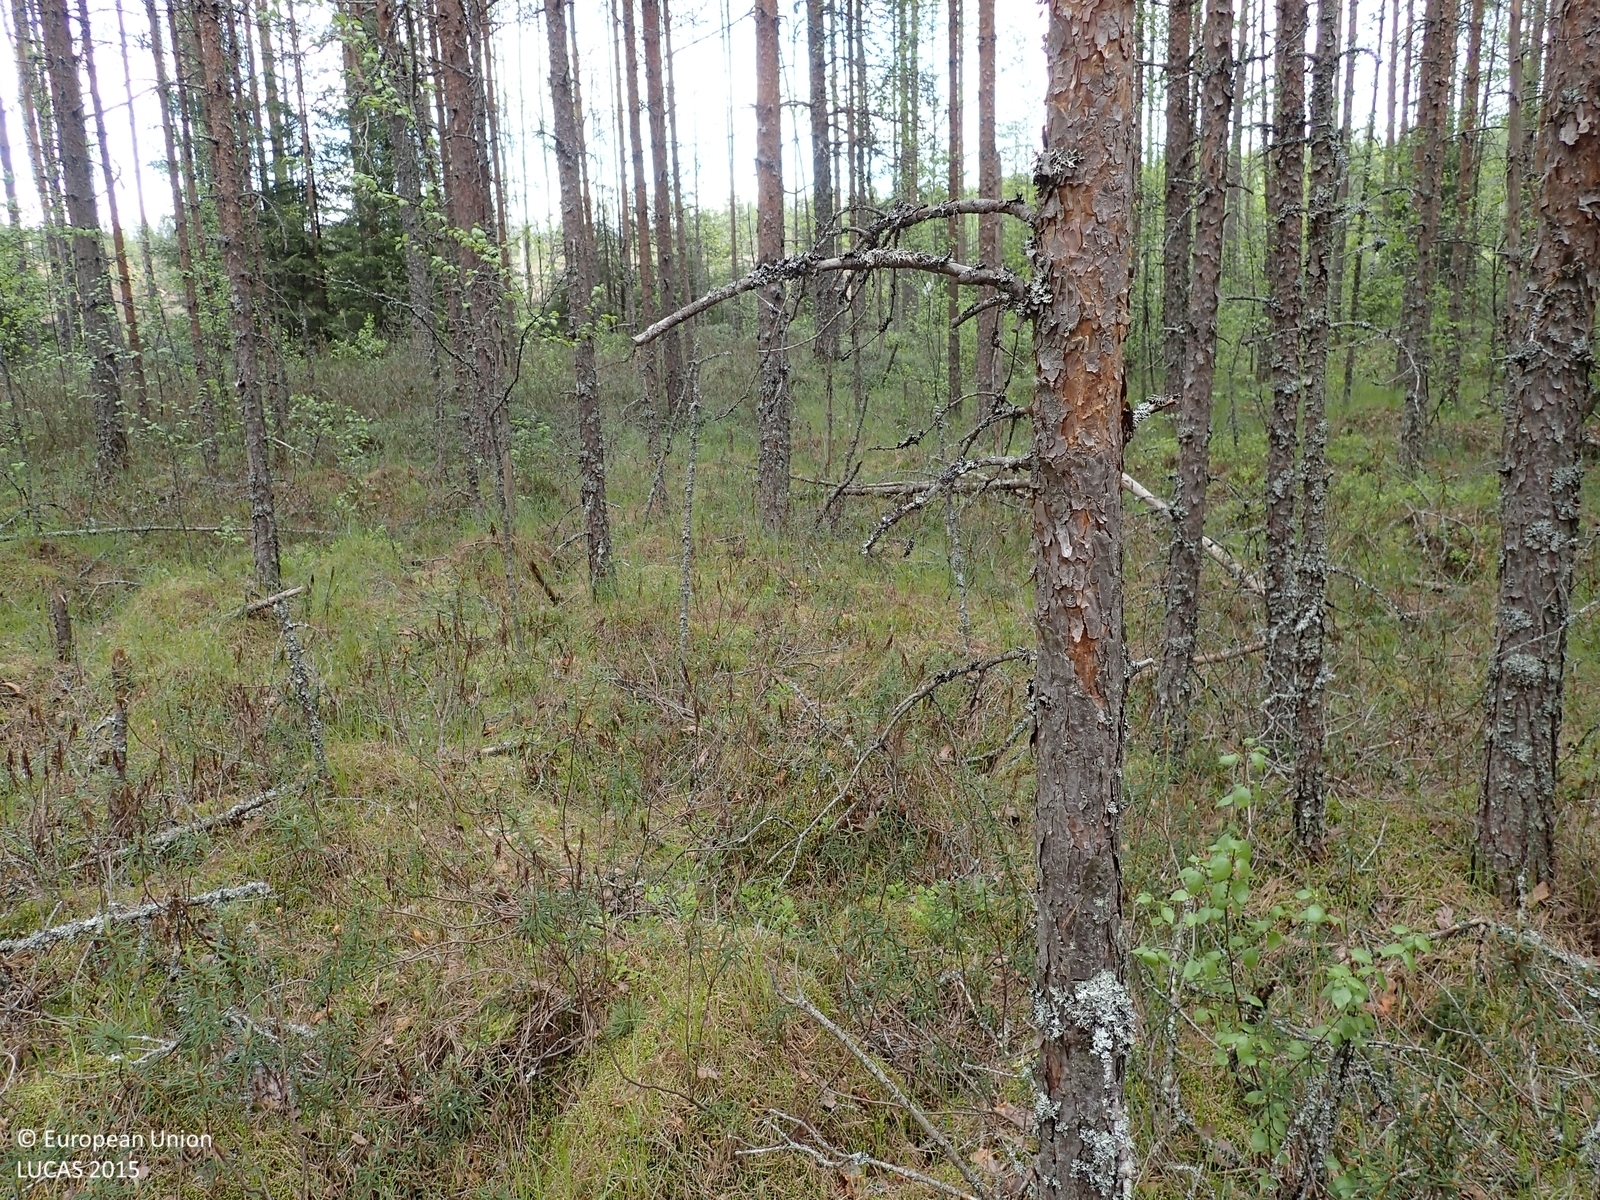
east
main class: Woodland
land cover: Pine dominated coniferous woodland
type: boreal forest
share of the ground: > 75 %
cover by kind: coniferous forest trees 80 %, shrubs 10 %, broadleaved forest trees 5 %, lichens and mosses 5 %
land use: Forestry
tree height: > 5 m
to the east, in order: Pine dominated coniferous woodland; Ditches and canals; Pine dominated coniferous woodland; Shrubland with sparse tree cover; Tracks; Shrubland with sparse tree cover
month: June
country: FI
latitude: 62.2375
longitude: 21.8067
